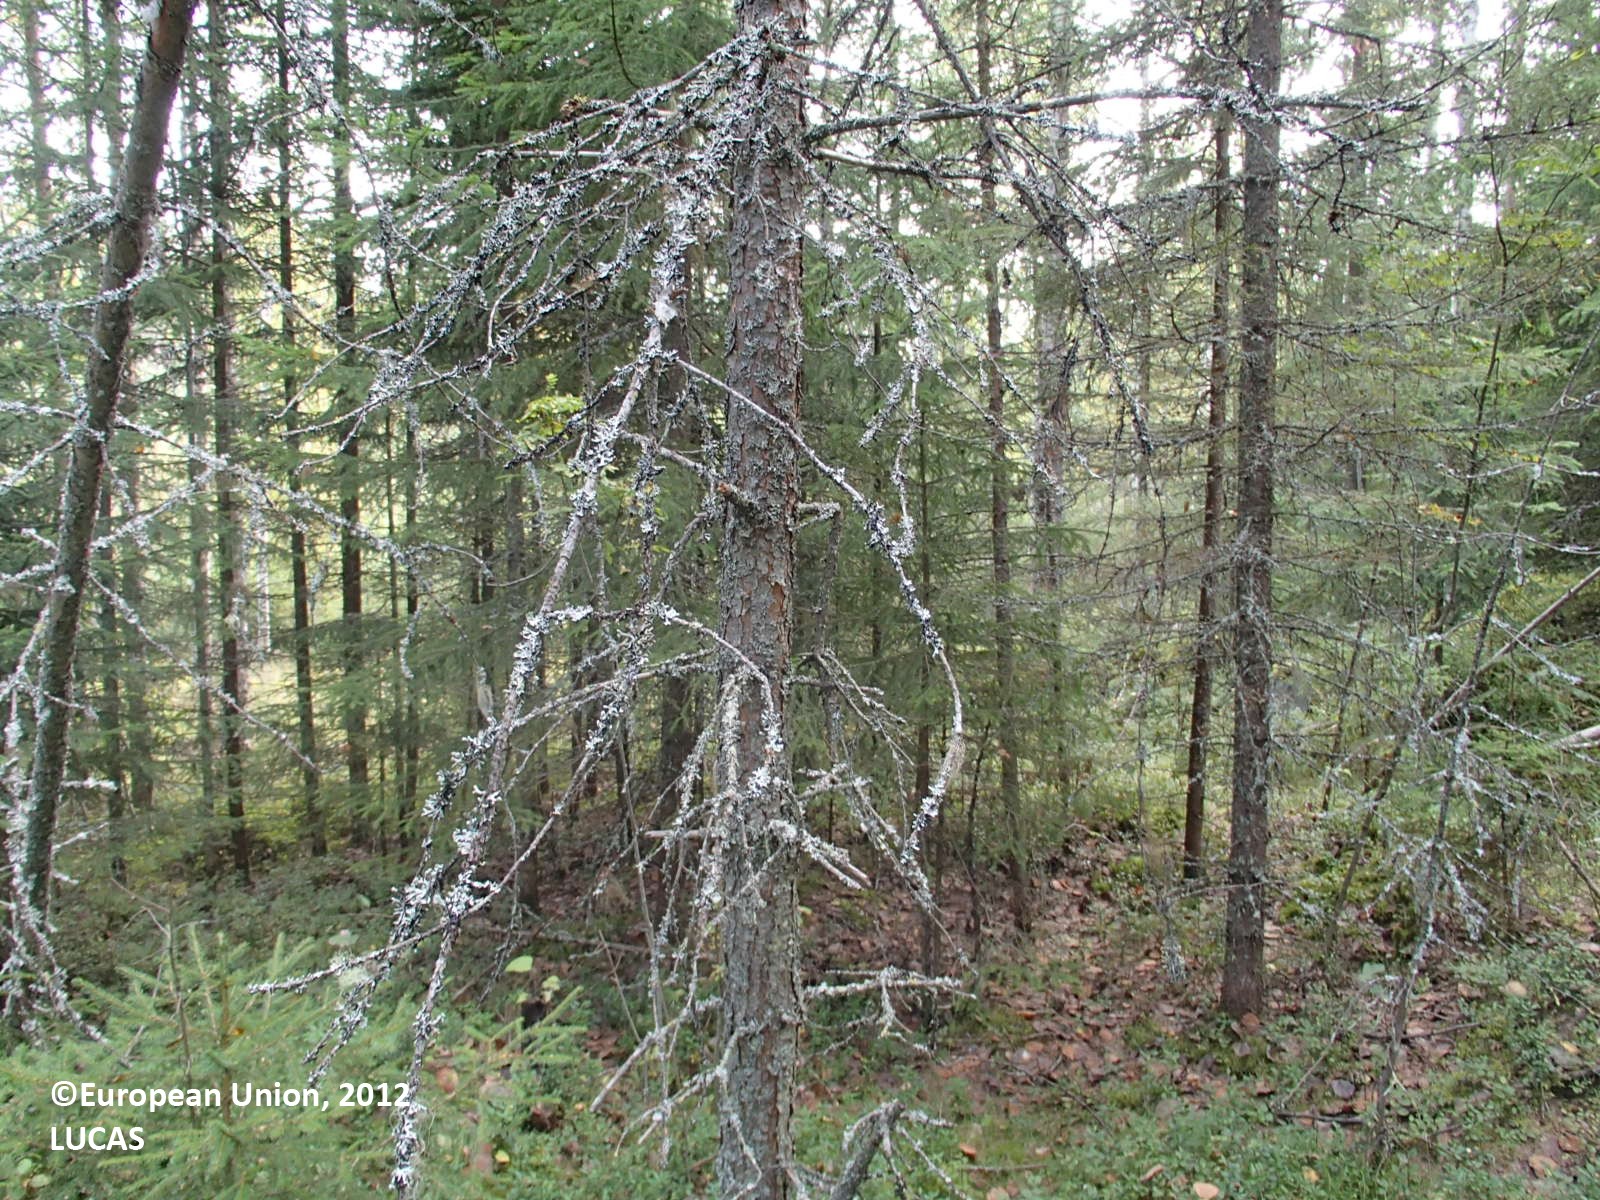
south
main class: Woodland
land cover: Other coniferous woodland
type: boreal forest
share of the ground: > 75 %
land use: Forestry
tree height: > 5 m
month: August
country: FI
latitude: 63.6640
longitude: 27.0924
